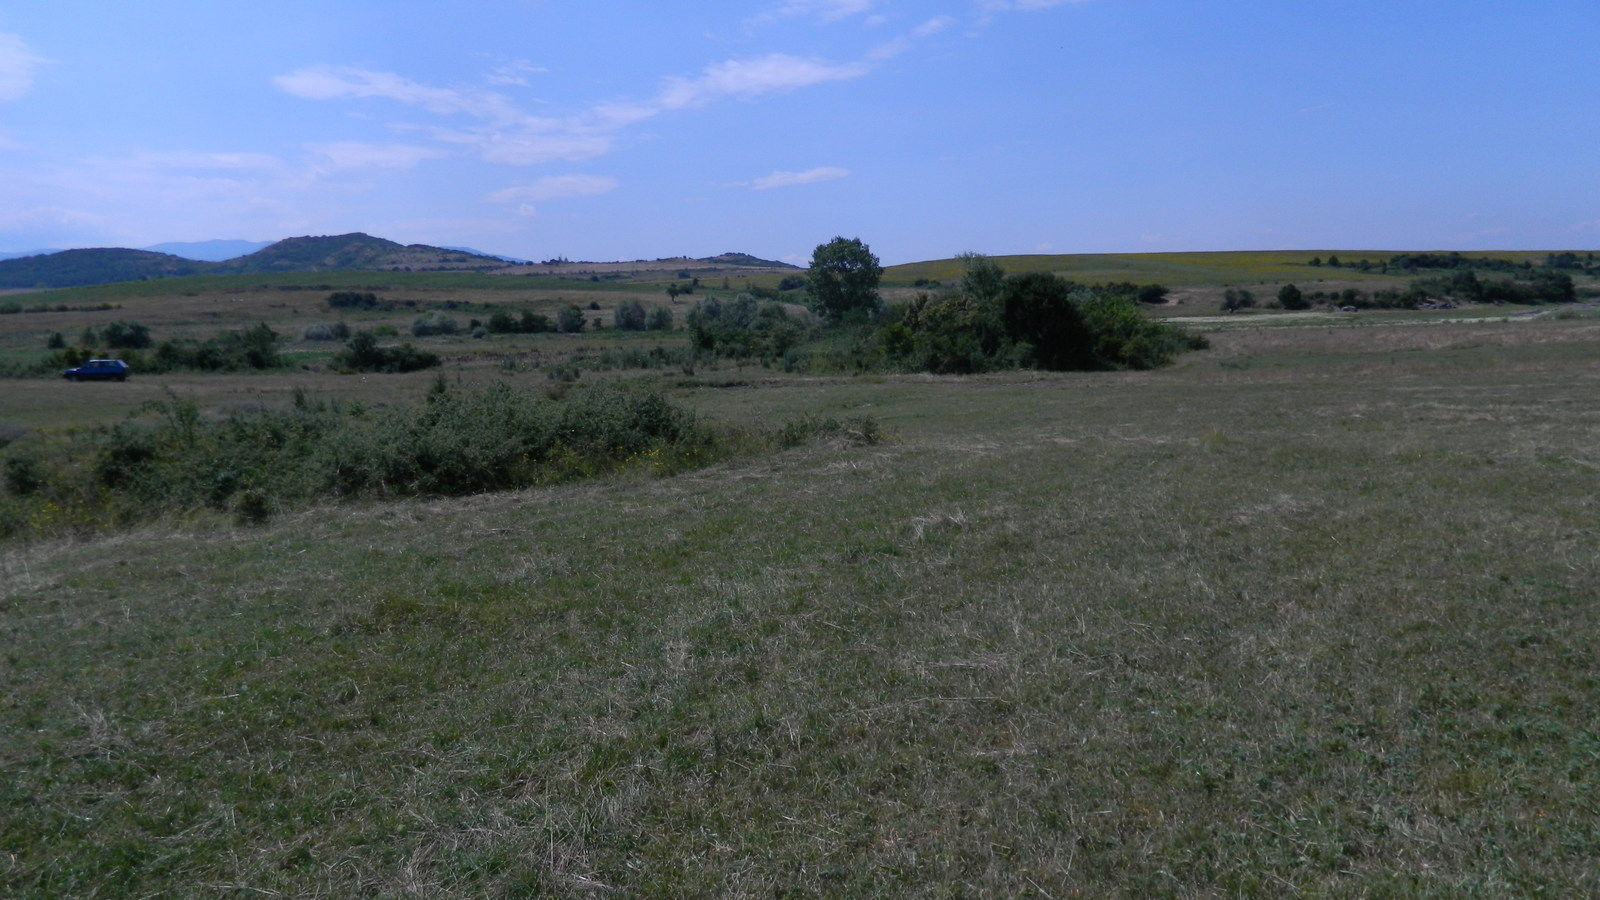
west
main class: Grassland
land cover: Grassland without tree/shrub cover
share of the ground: > 75 %
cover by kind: herbaceous plants 100 %
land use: Agriculture (excluding fallow land and kitchen gardens)
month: July
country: BG
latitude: 41.9475
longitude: 25.1471
